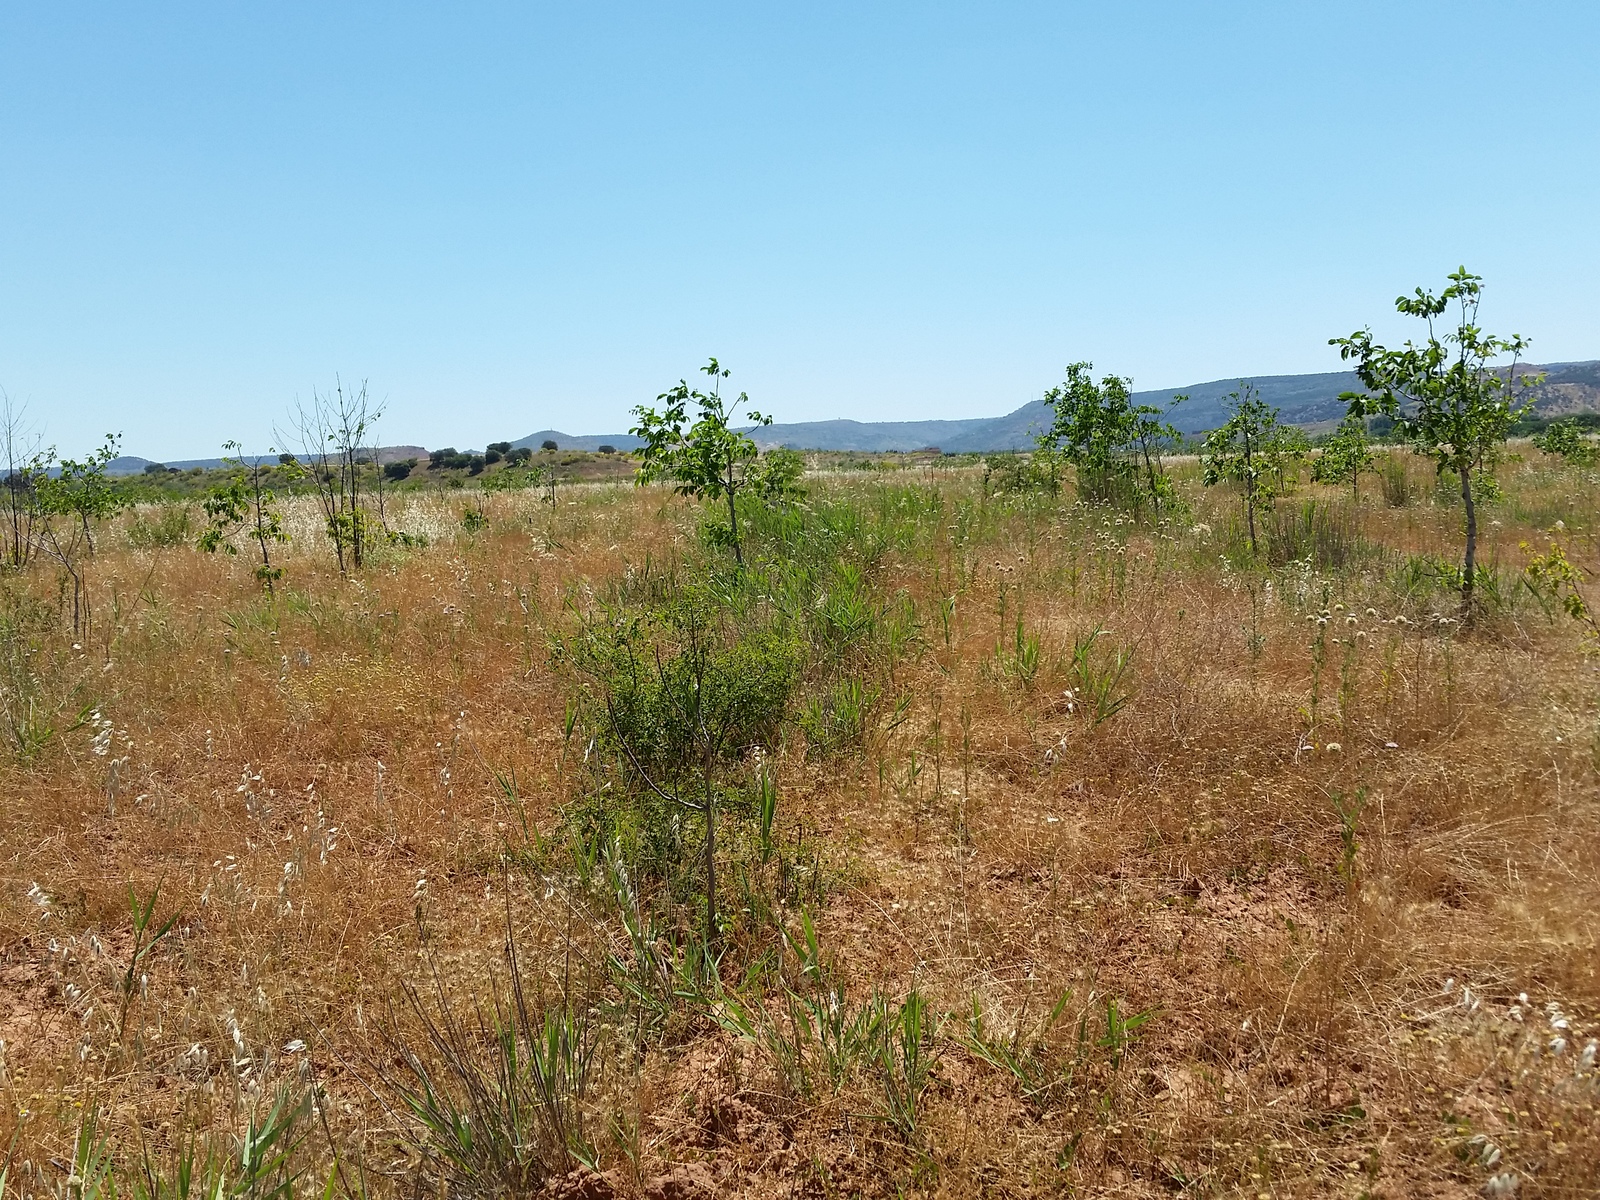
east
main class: Cropland
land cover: Nuts trees
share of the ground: 25 - 50 %
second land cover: Grassland without tree/shrub cover
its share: > 75 %
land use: Agriculture (excluding fallow land and kitchen gardens)
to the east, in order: Nuts trees; Grassland without tree/shrub cover
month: June
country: ES
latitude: 38.6694
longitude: -2.5641
